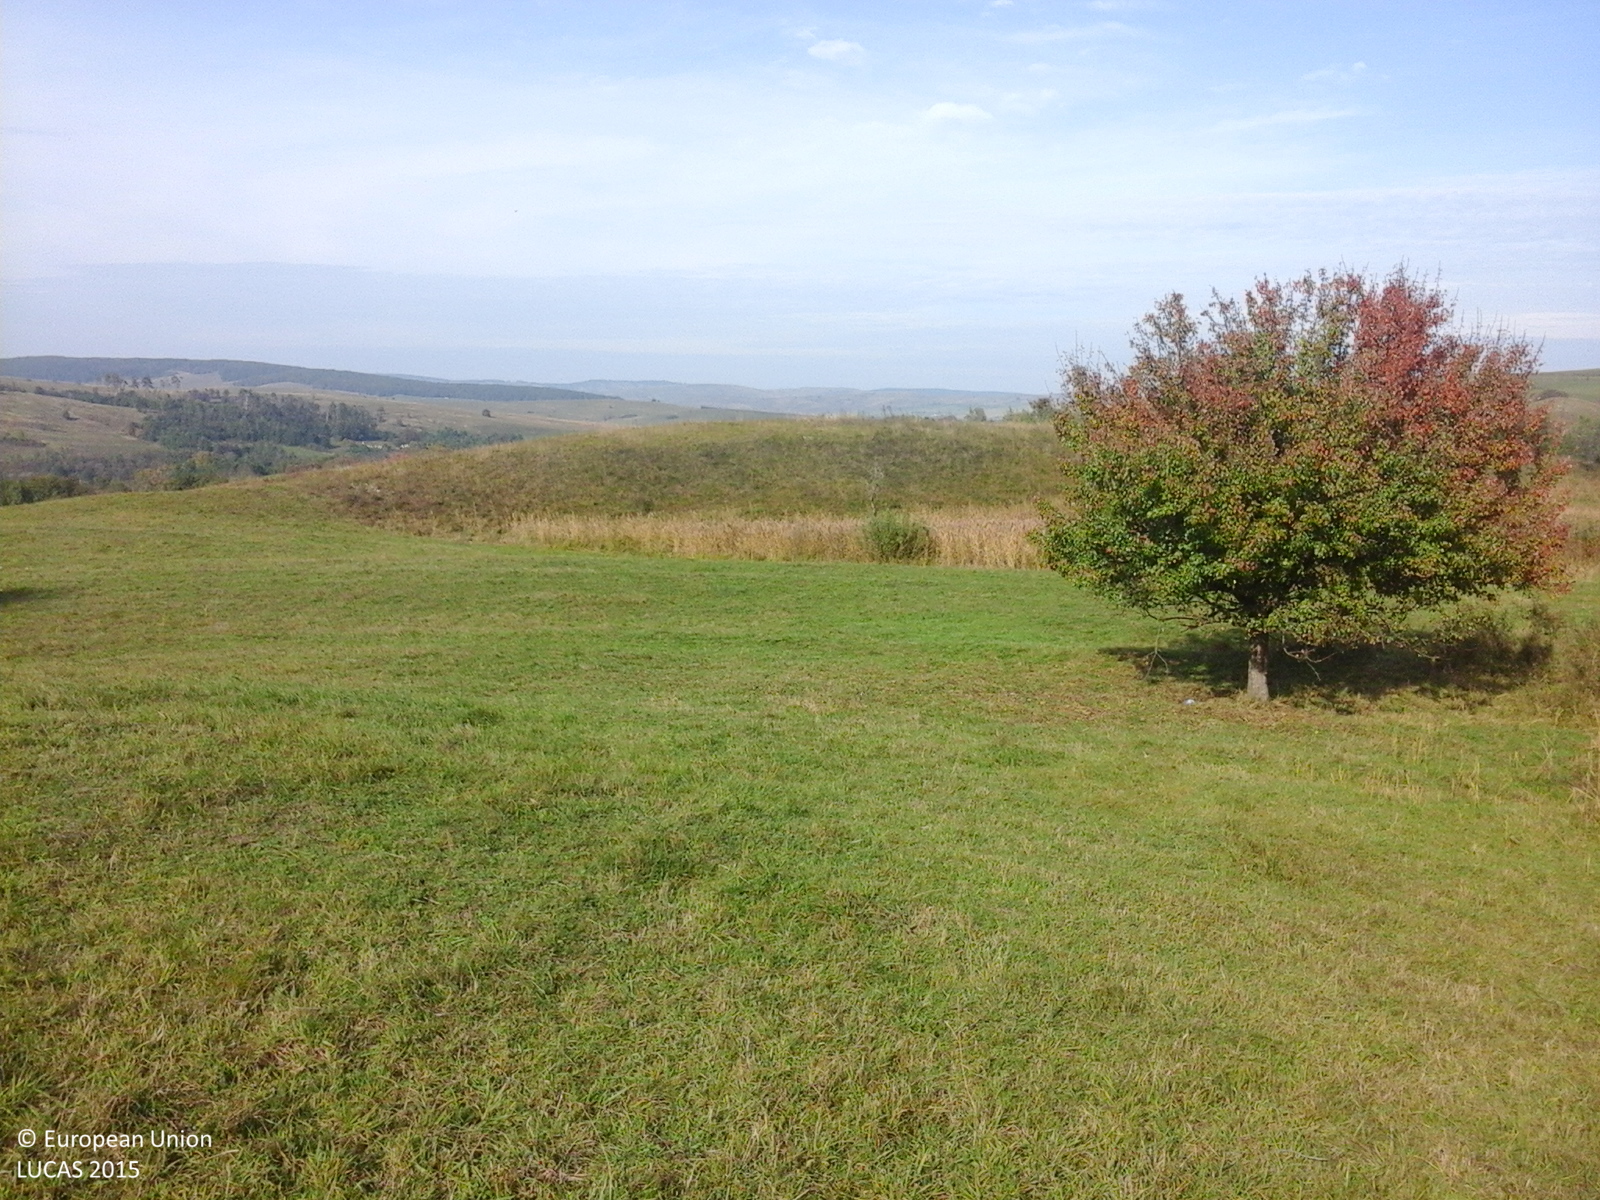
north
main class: Grassland
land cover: Grassland without tree/shrub cover
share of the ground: > 75 %
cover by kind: herbaceous plants 100 %
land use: Agriculture (excluding fallow land and kitchen gardens)
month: October
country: RO
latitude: 45.9497
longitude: 24.9672
